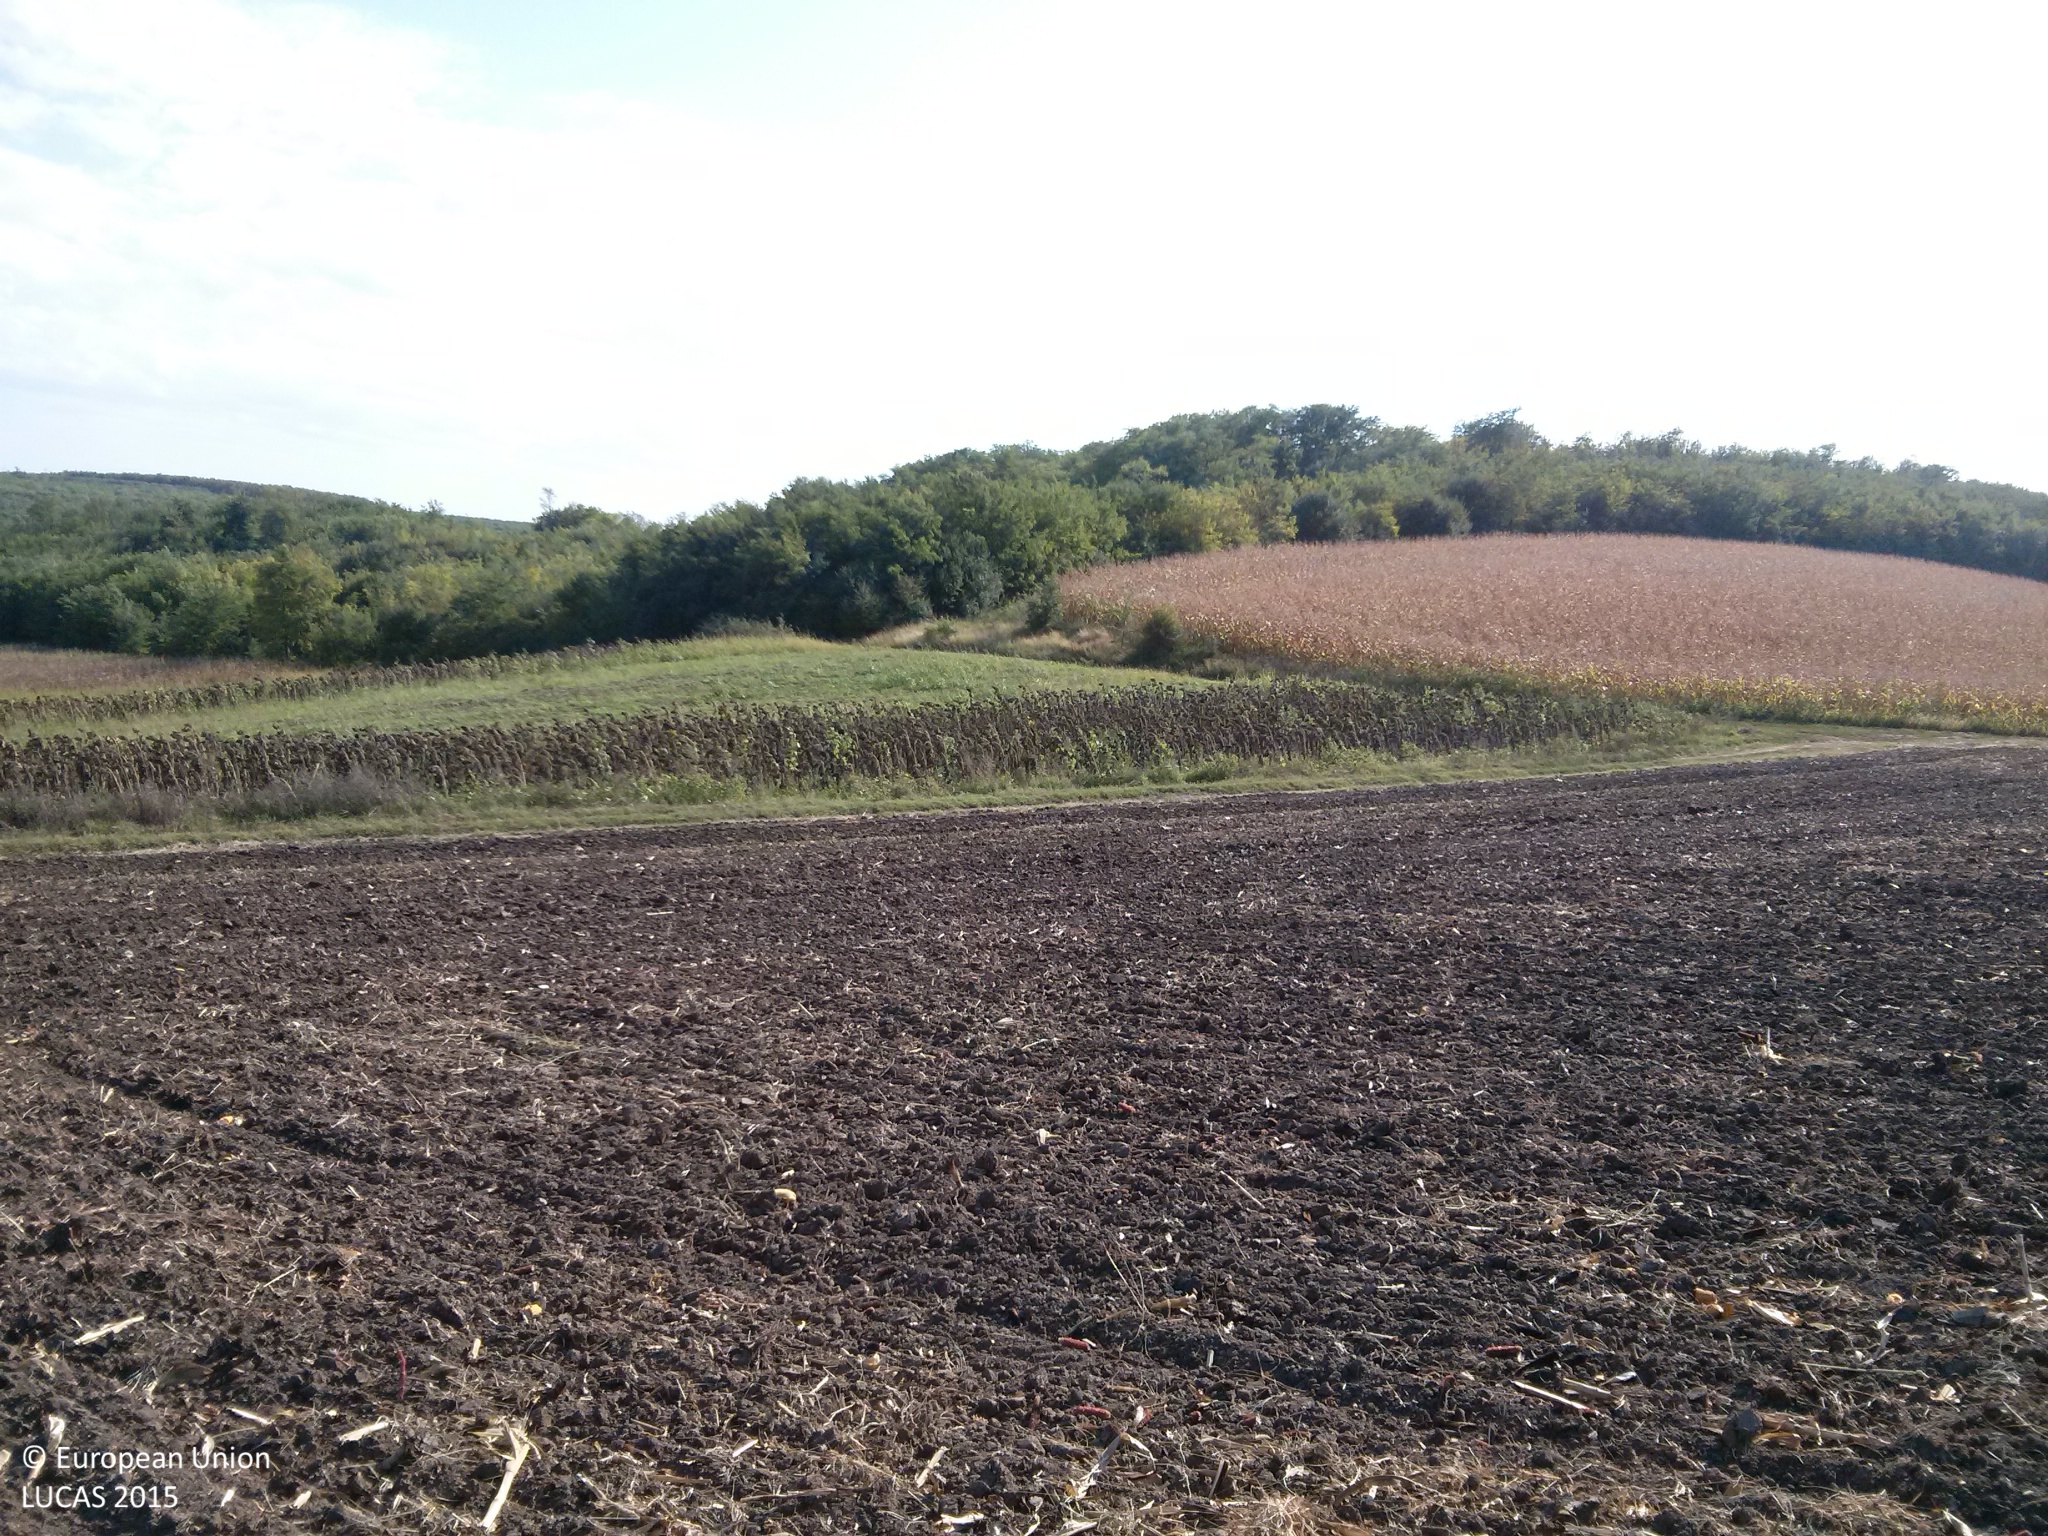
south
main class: Cropland
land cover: Maize
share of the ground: < 10 %
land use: Agriculture (excluding fallow land and kitchen gardens)
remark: Harvested field
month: September
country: BG
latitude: 43.9038
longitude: 26.4815
